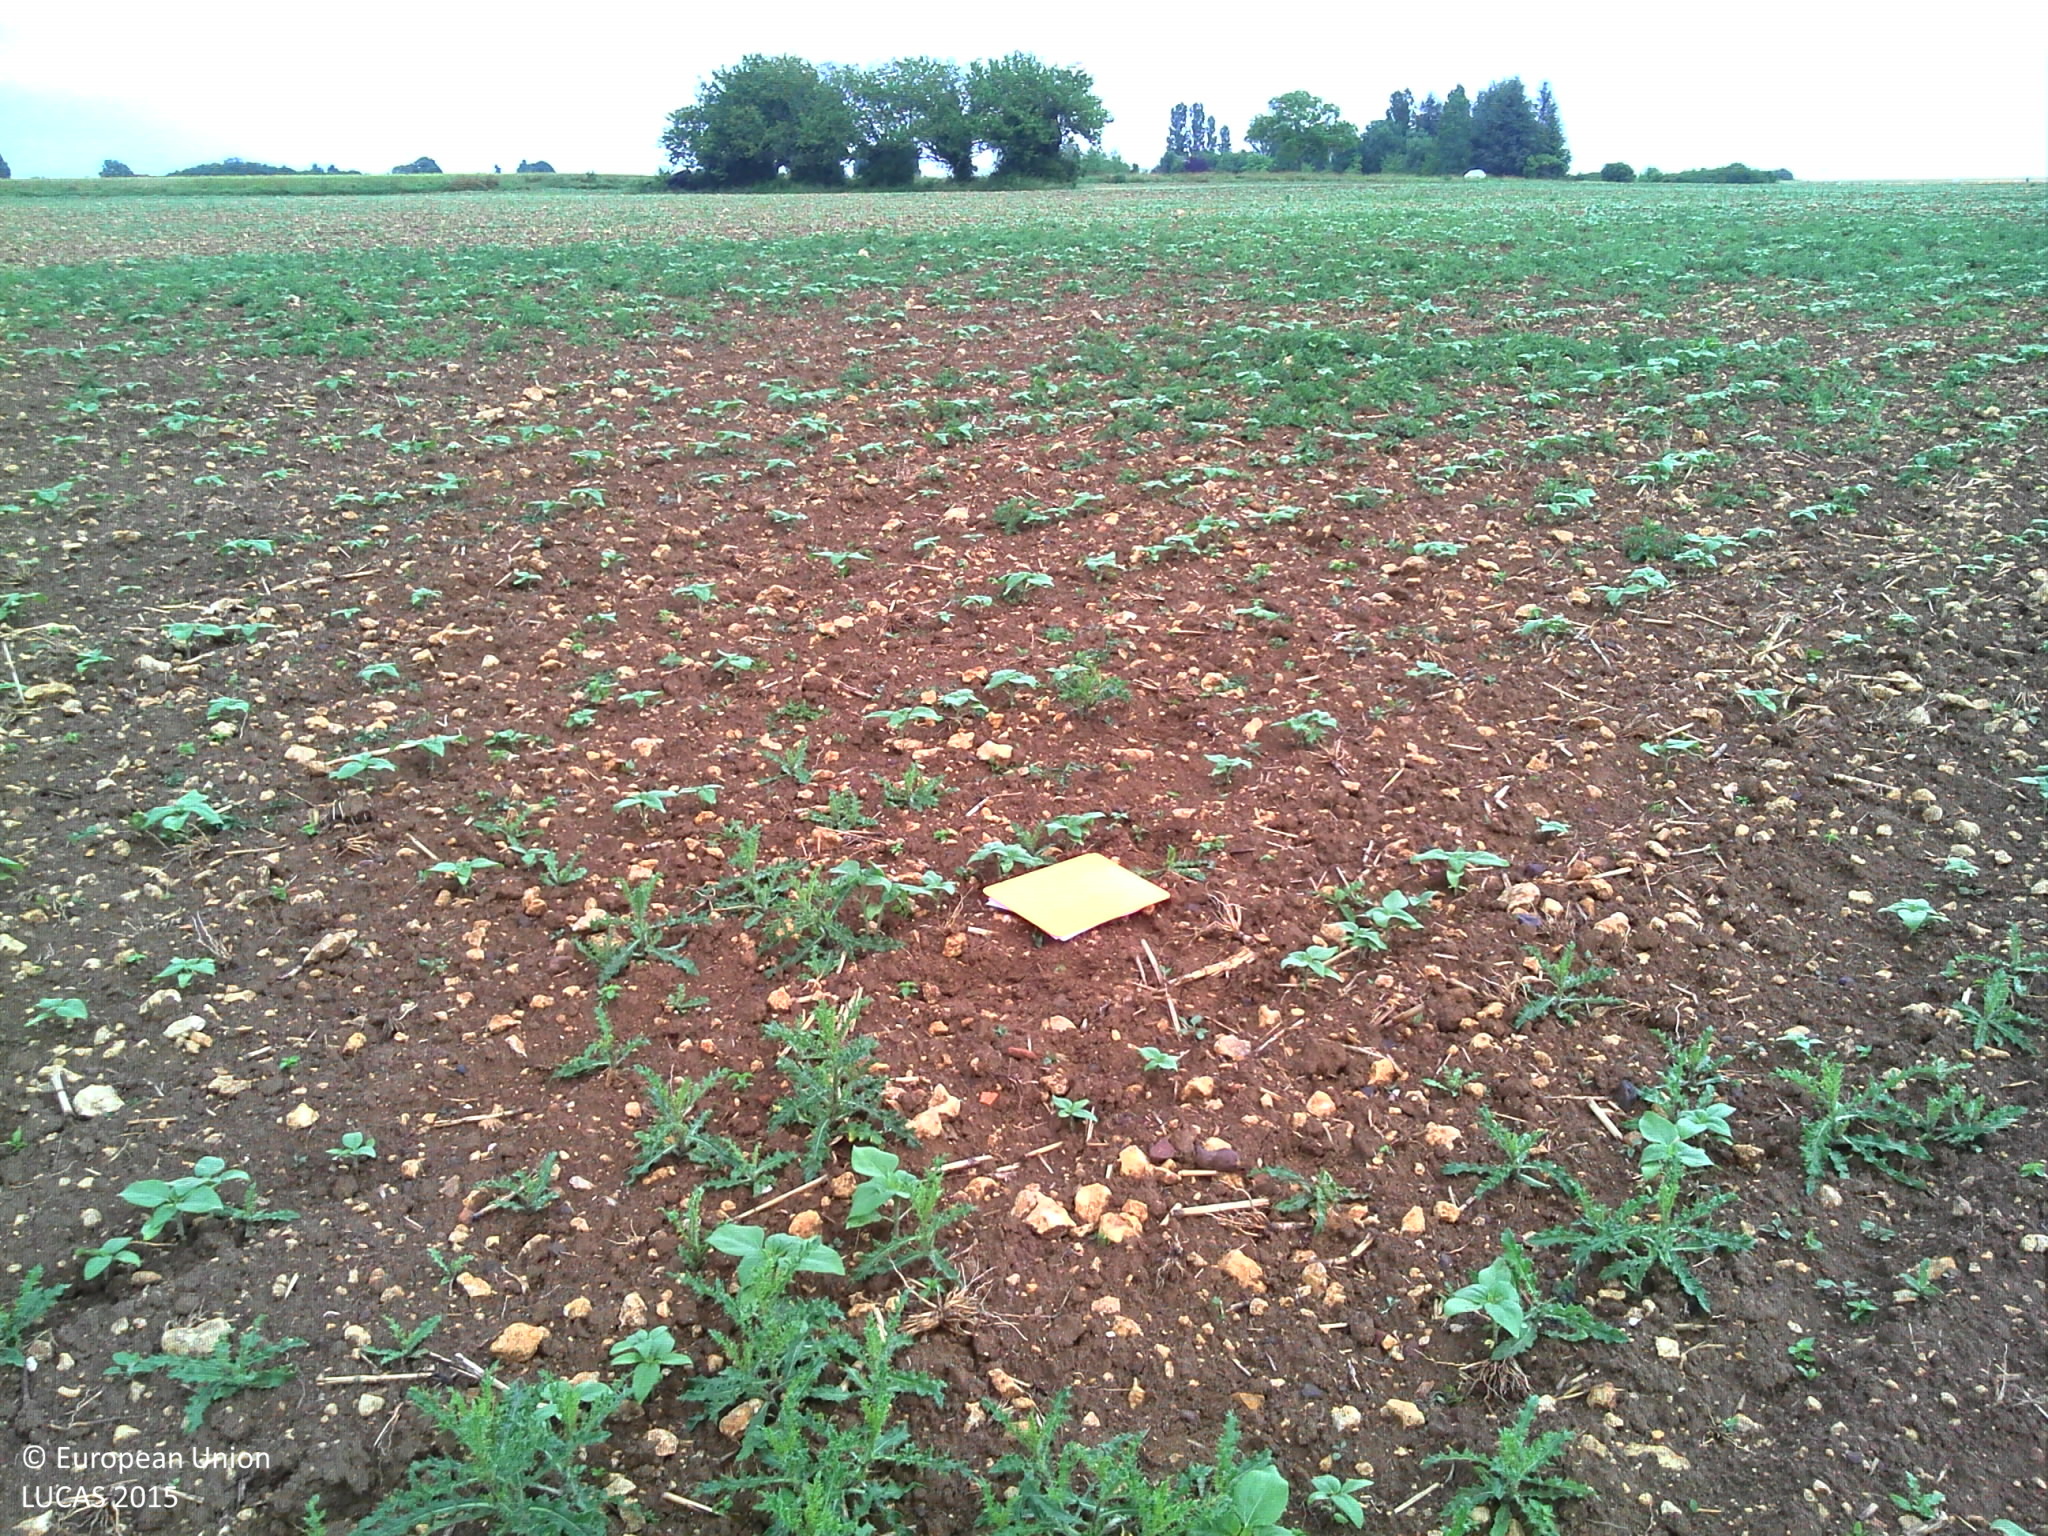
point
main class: Cropland
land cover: Sunflower
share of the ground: 10 - 25 %
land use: Agriculture (excluding fallow land and kitchen gardens)
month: June
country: FR
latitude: 46.6200
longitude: 0.5407
